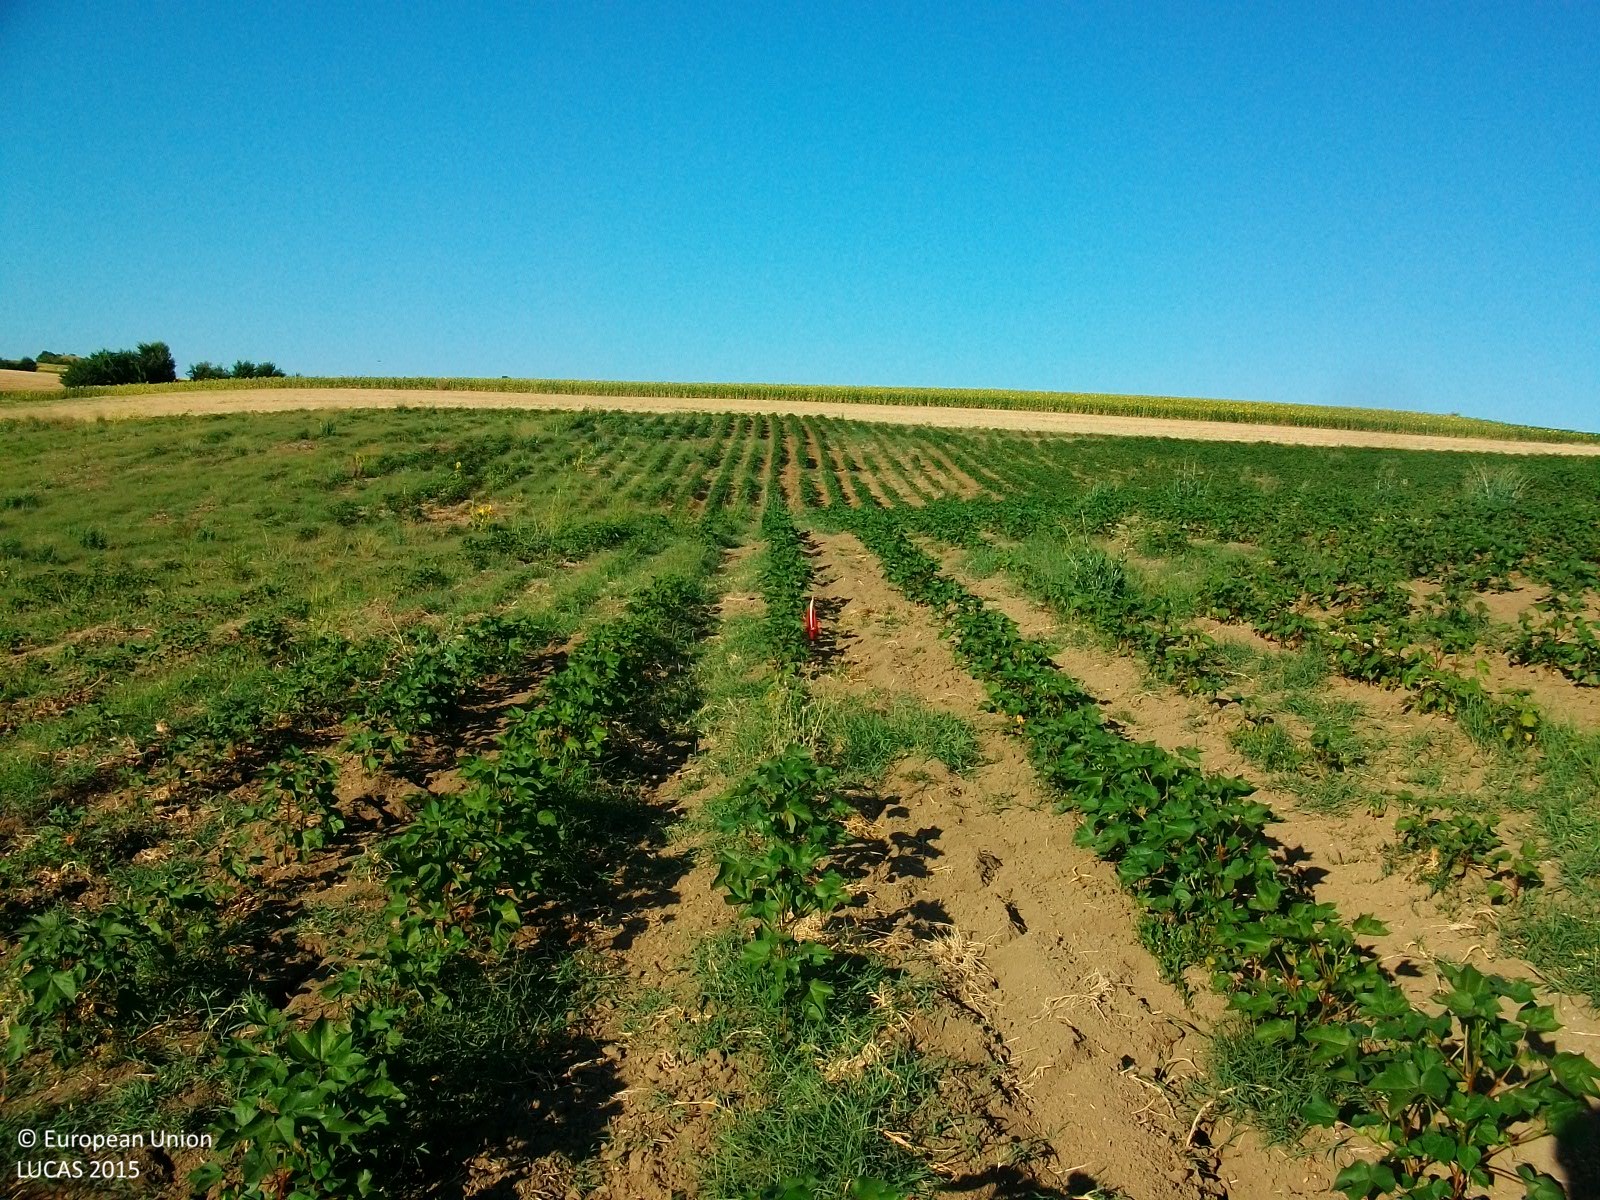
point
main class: Cropland
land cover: Cotton
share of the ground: 25 - 50 %
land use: Agriculture (excluding fallow land and kitchen gardens)
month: July
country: GR
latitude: 41.4607
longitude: 26.2470
